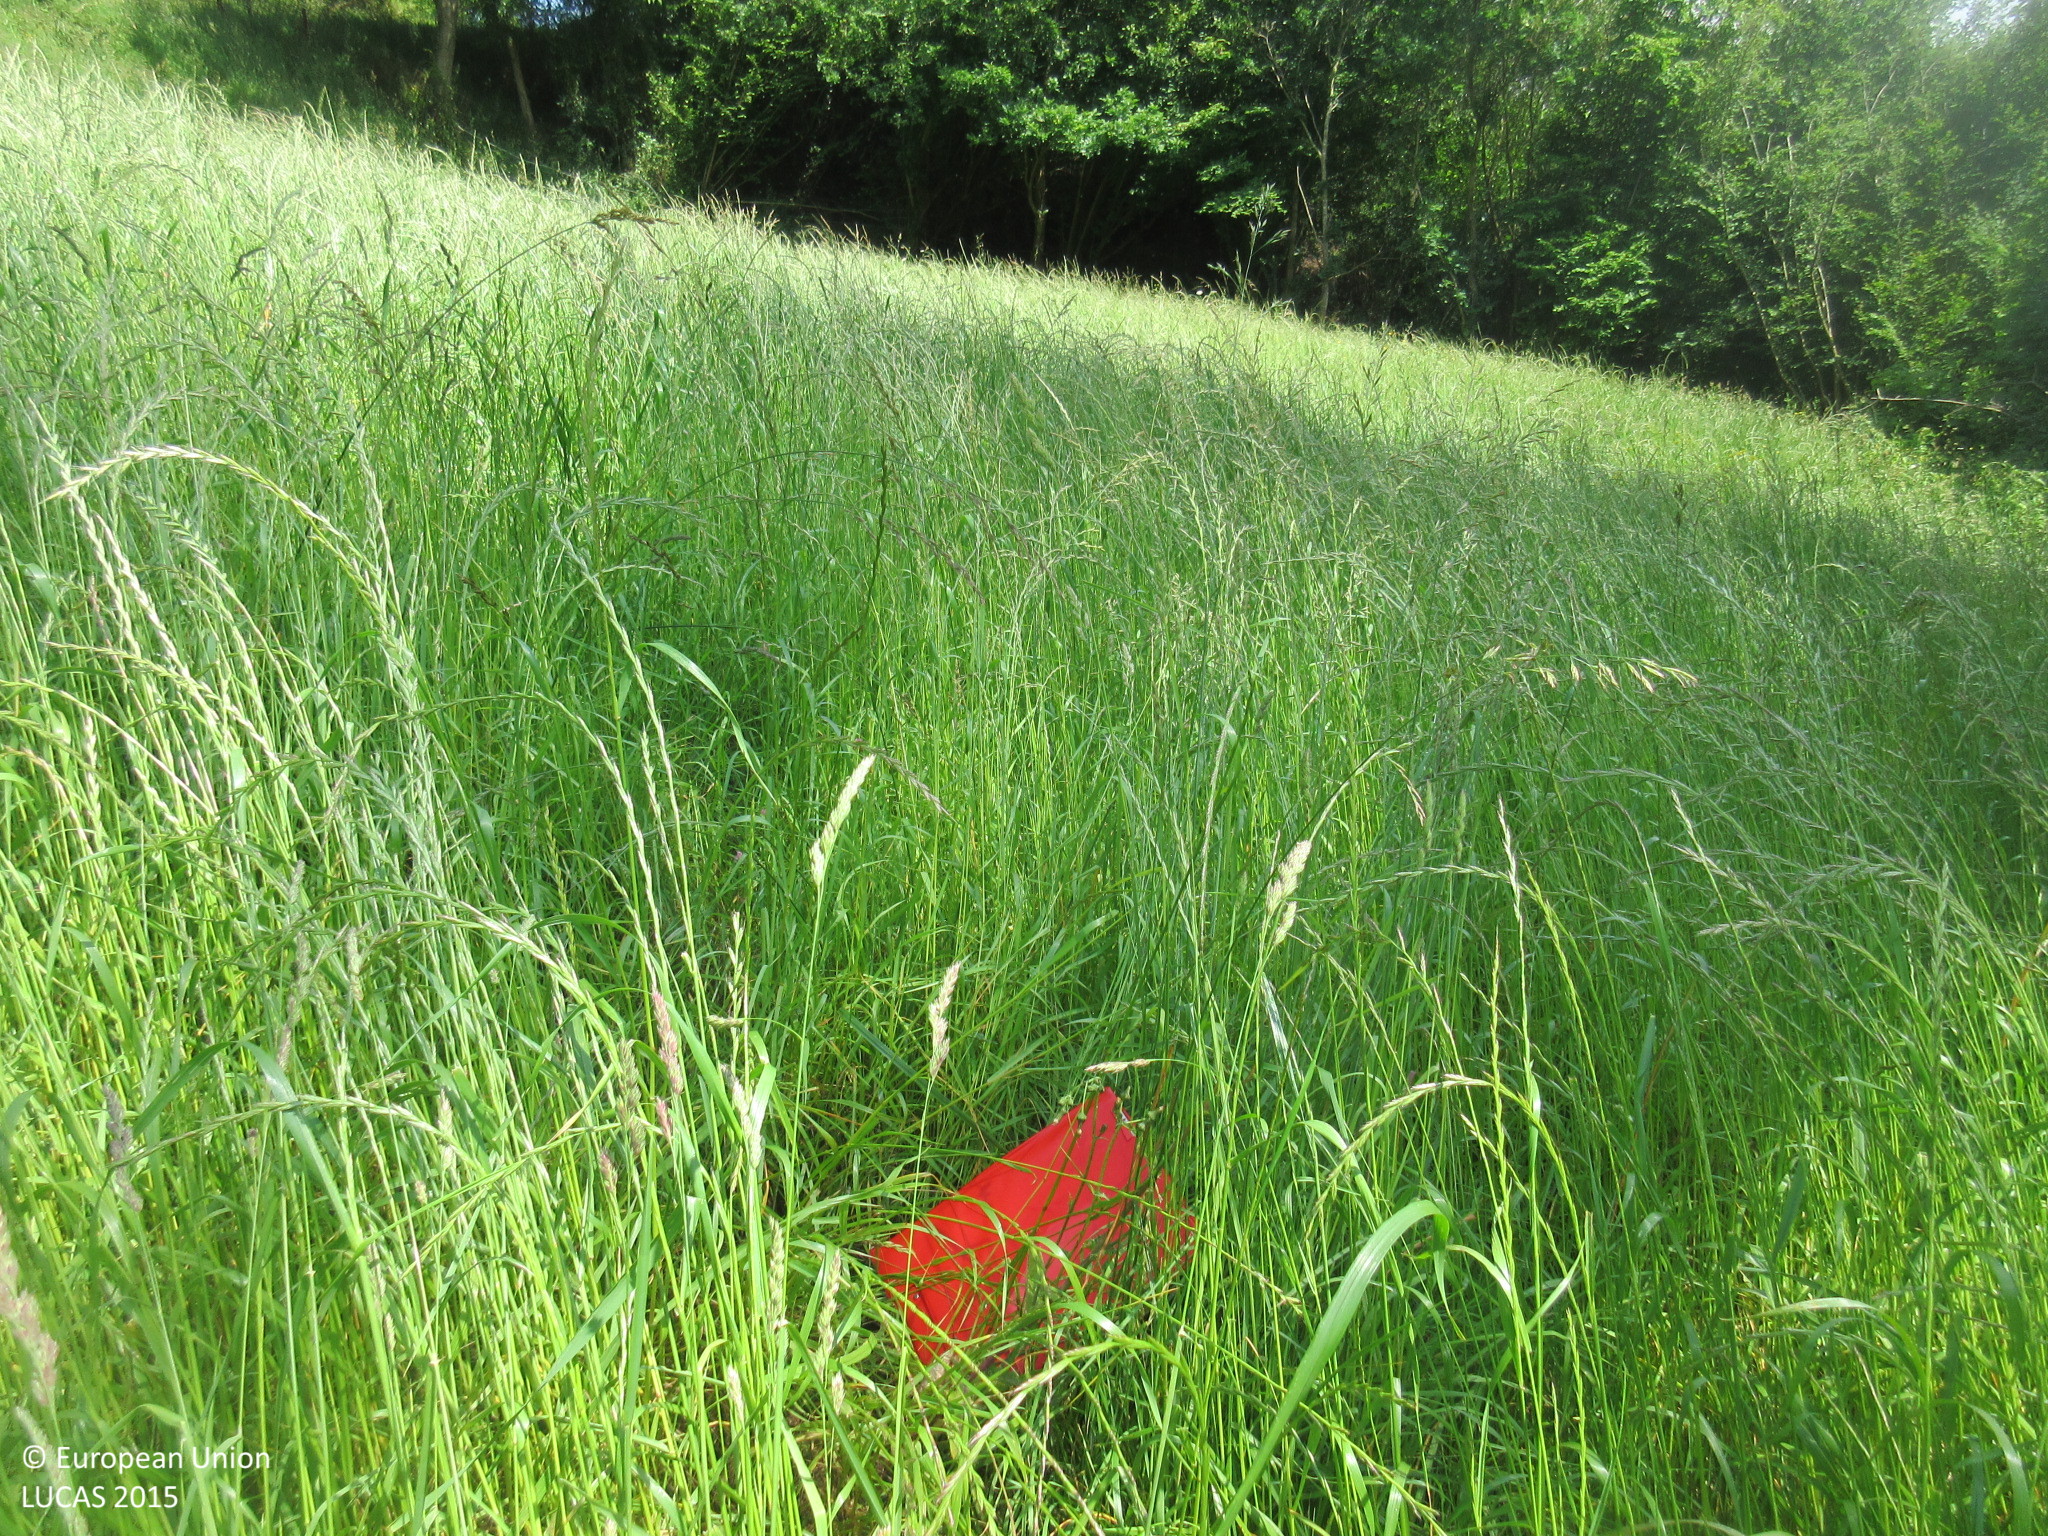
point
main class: Grassland
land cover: Grassland without tree/shrub cover
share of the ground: > 75 %
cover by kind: herbaceous plants 100 %
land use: Agriculture (excluding fallow land and kitchen gardens)
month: May
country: ES
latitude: 43.3329
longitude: -4.5779
